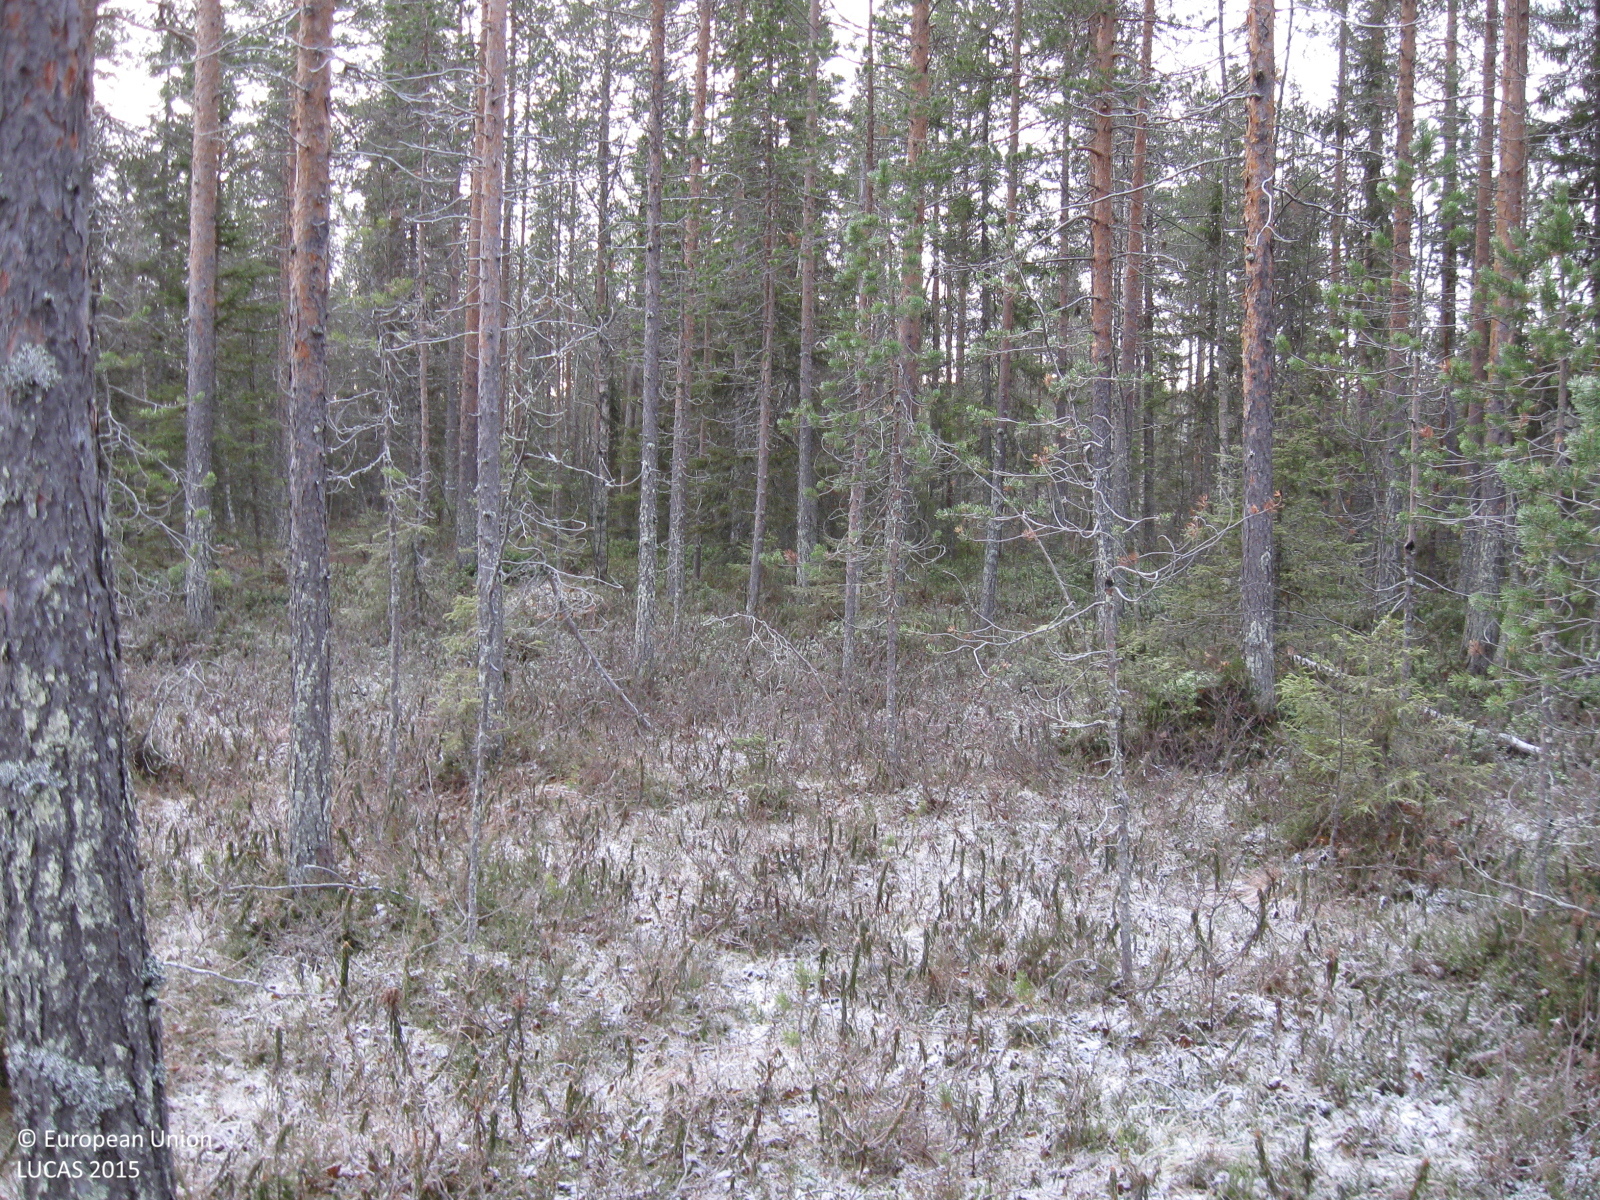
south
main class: Woodland
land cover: Pine dominated coniferous woodland
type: mire and swamp forests
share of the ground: 50 - 75 %
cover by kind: coniferous forest trees 55 %, shrubs 25 %, herbaceous plants 10 %, lichens and mosses 10 %
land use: Forestry
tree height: > 5 m
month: October
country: SE
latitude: 66.1146
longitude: 21.3198
